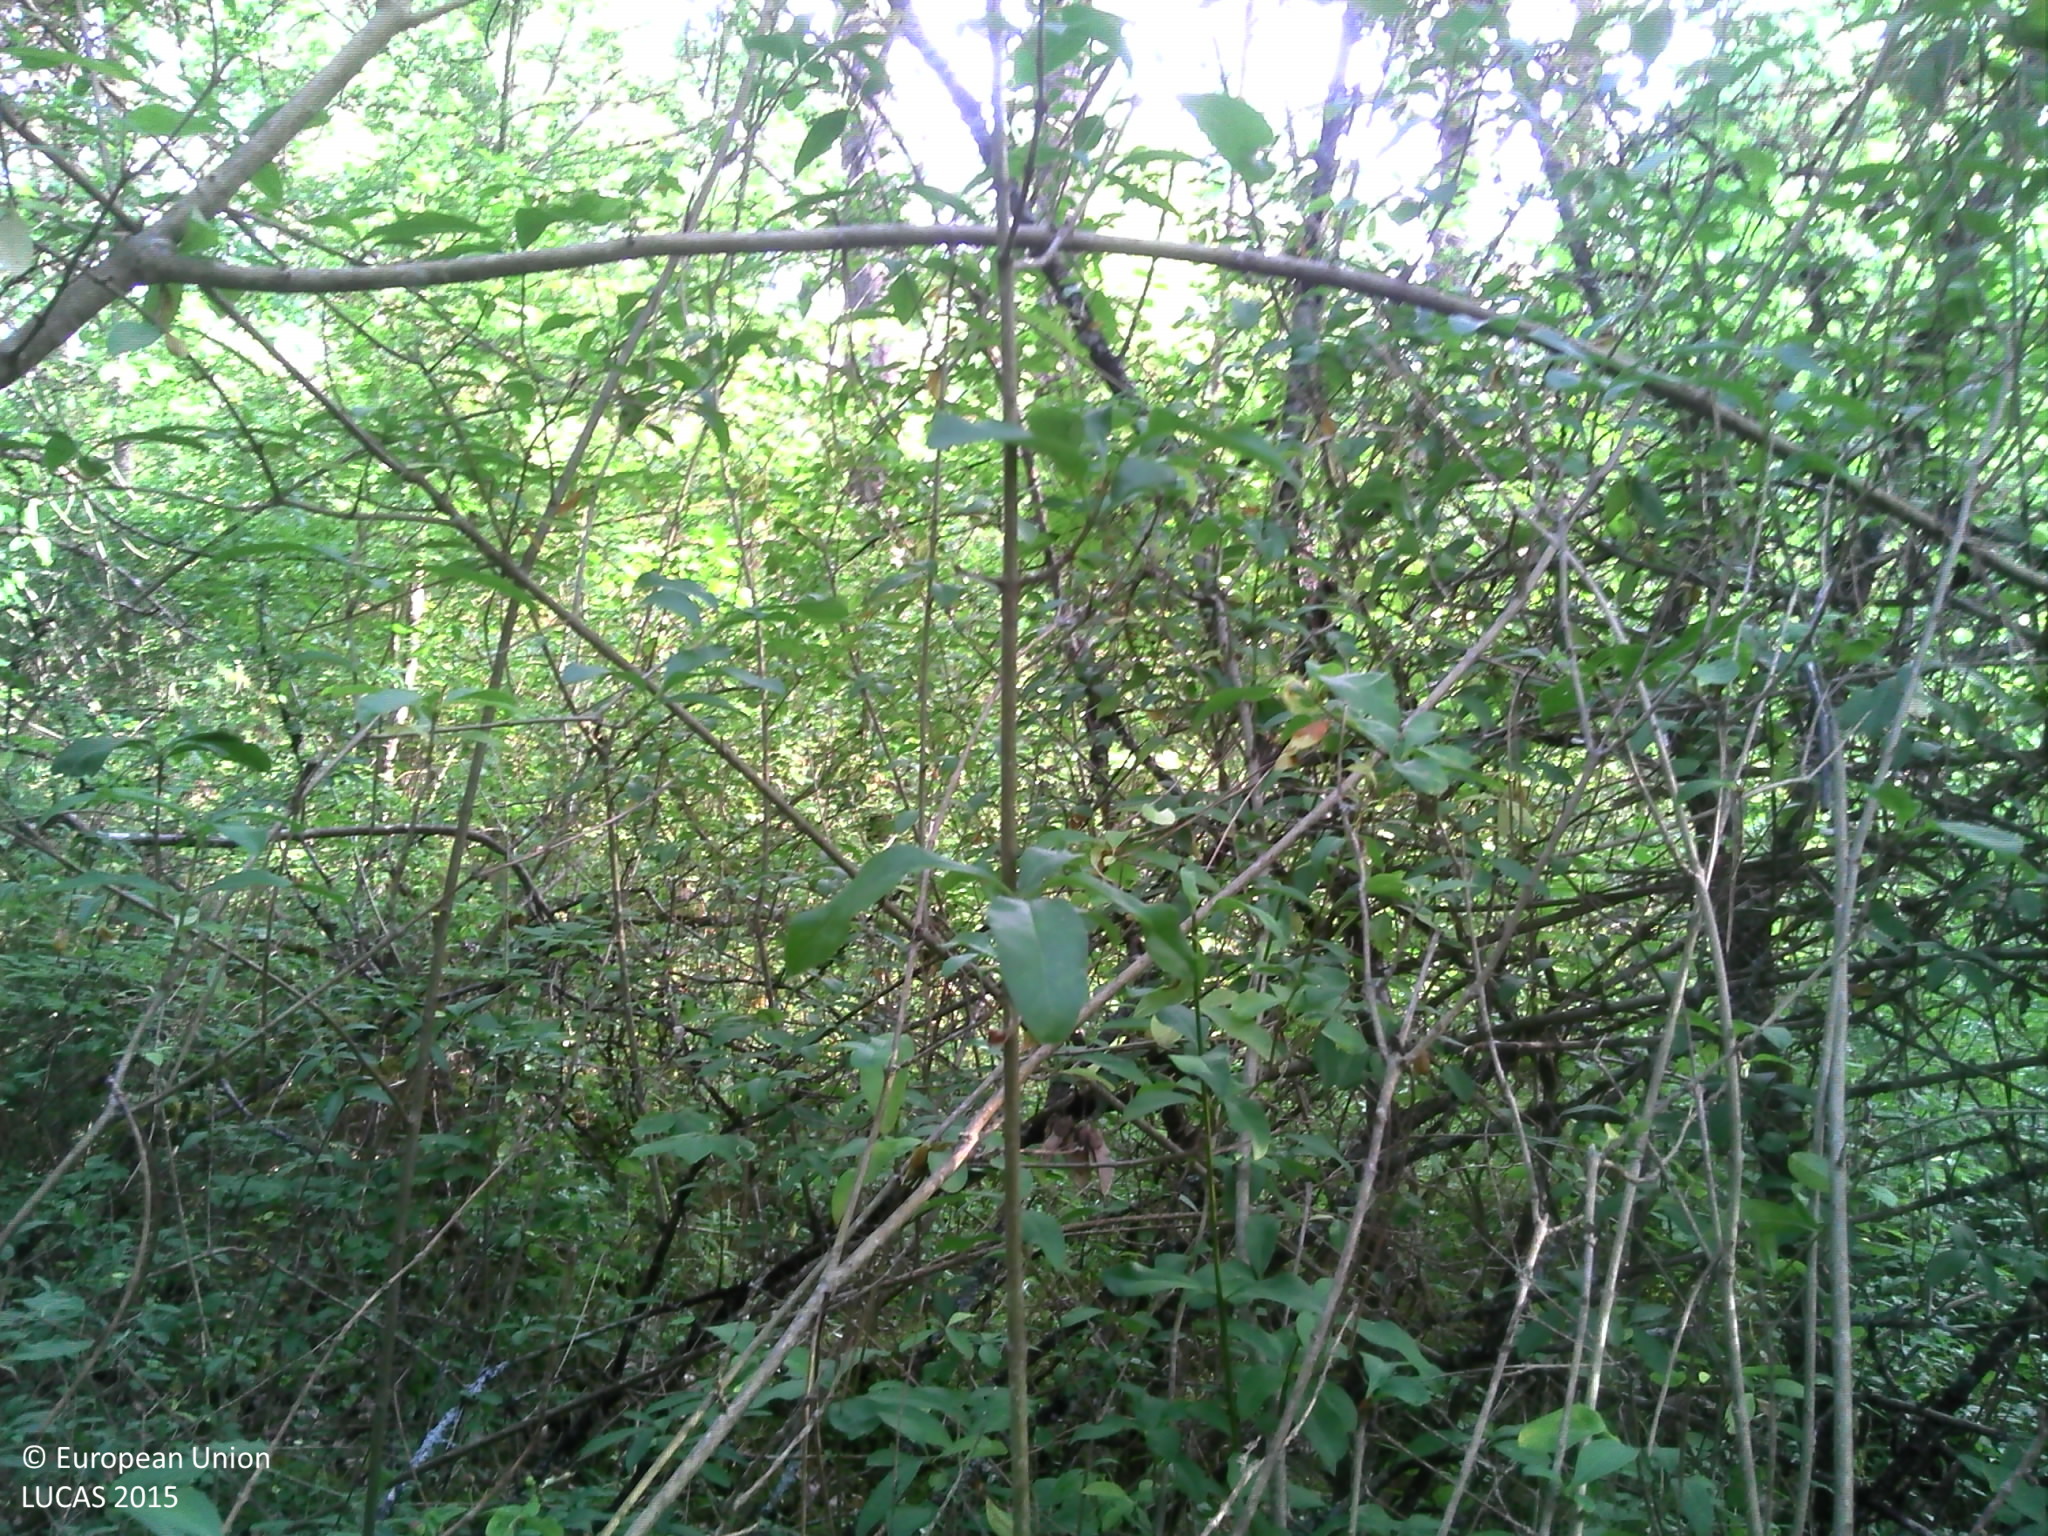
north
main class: Woodland
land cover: Pine dominated coniferous woodland
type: mesophytic deciduous forest
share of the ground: > 75 %
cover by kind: coniferous forest trees 80 %, broadleaved forest trees 10 %, herbaceous plants 5 %, lichens and mosses 5 %
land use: Semi-natural and natural areas not in use
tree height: > 5 m
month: July
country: FR
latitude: 47.6743
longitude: 3.5628
